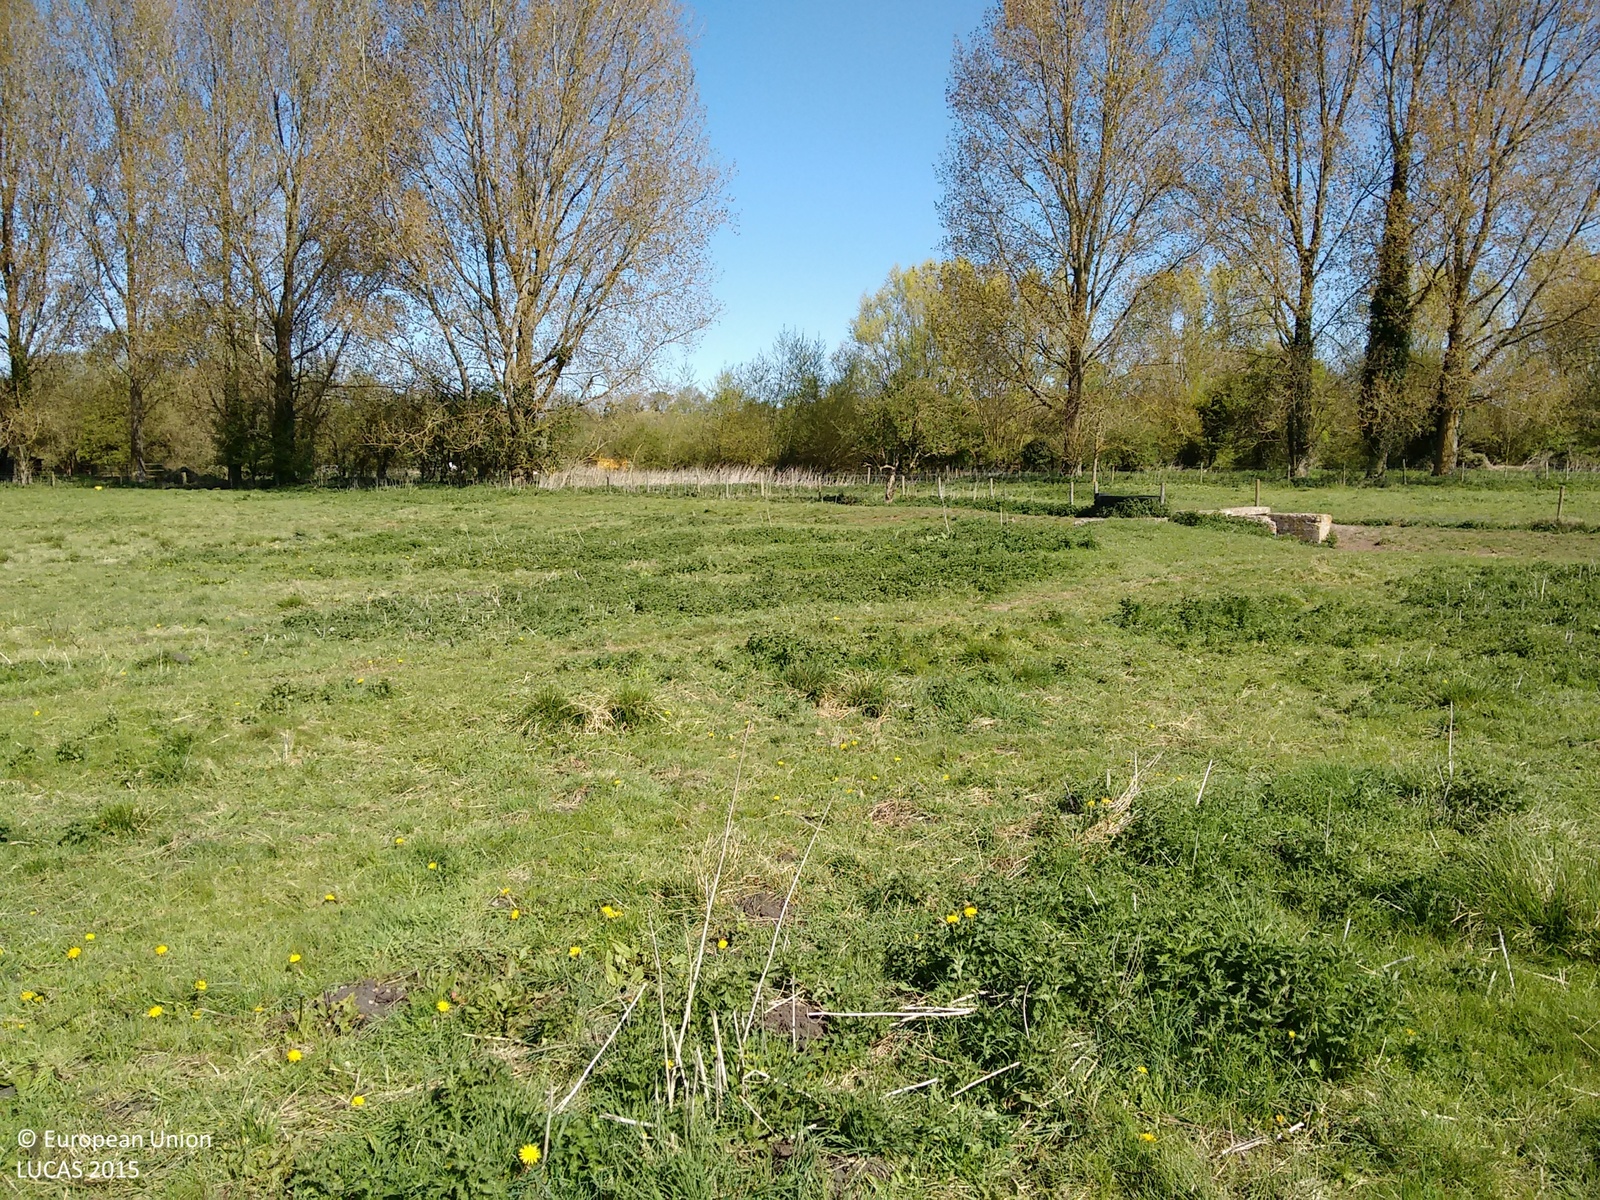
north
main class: Grassland
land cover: Grassland without tree/shrub cover
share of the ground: > 75 %
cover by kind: herbaceous plants 100 %
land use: Agriculture (excluding fallow land and kitchen gardens)
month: April
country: GB
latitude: 51.1704
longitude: -1.4203
